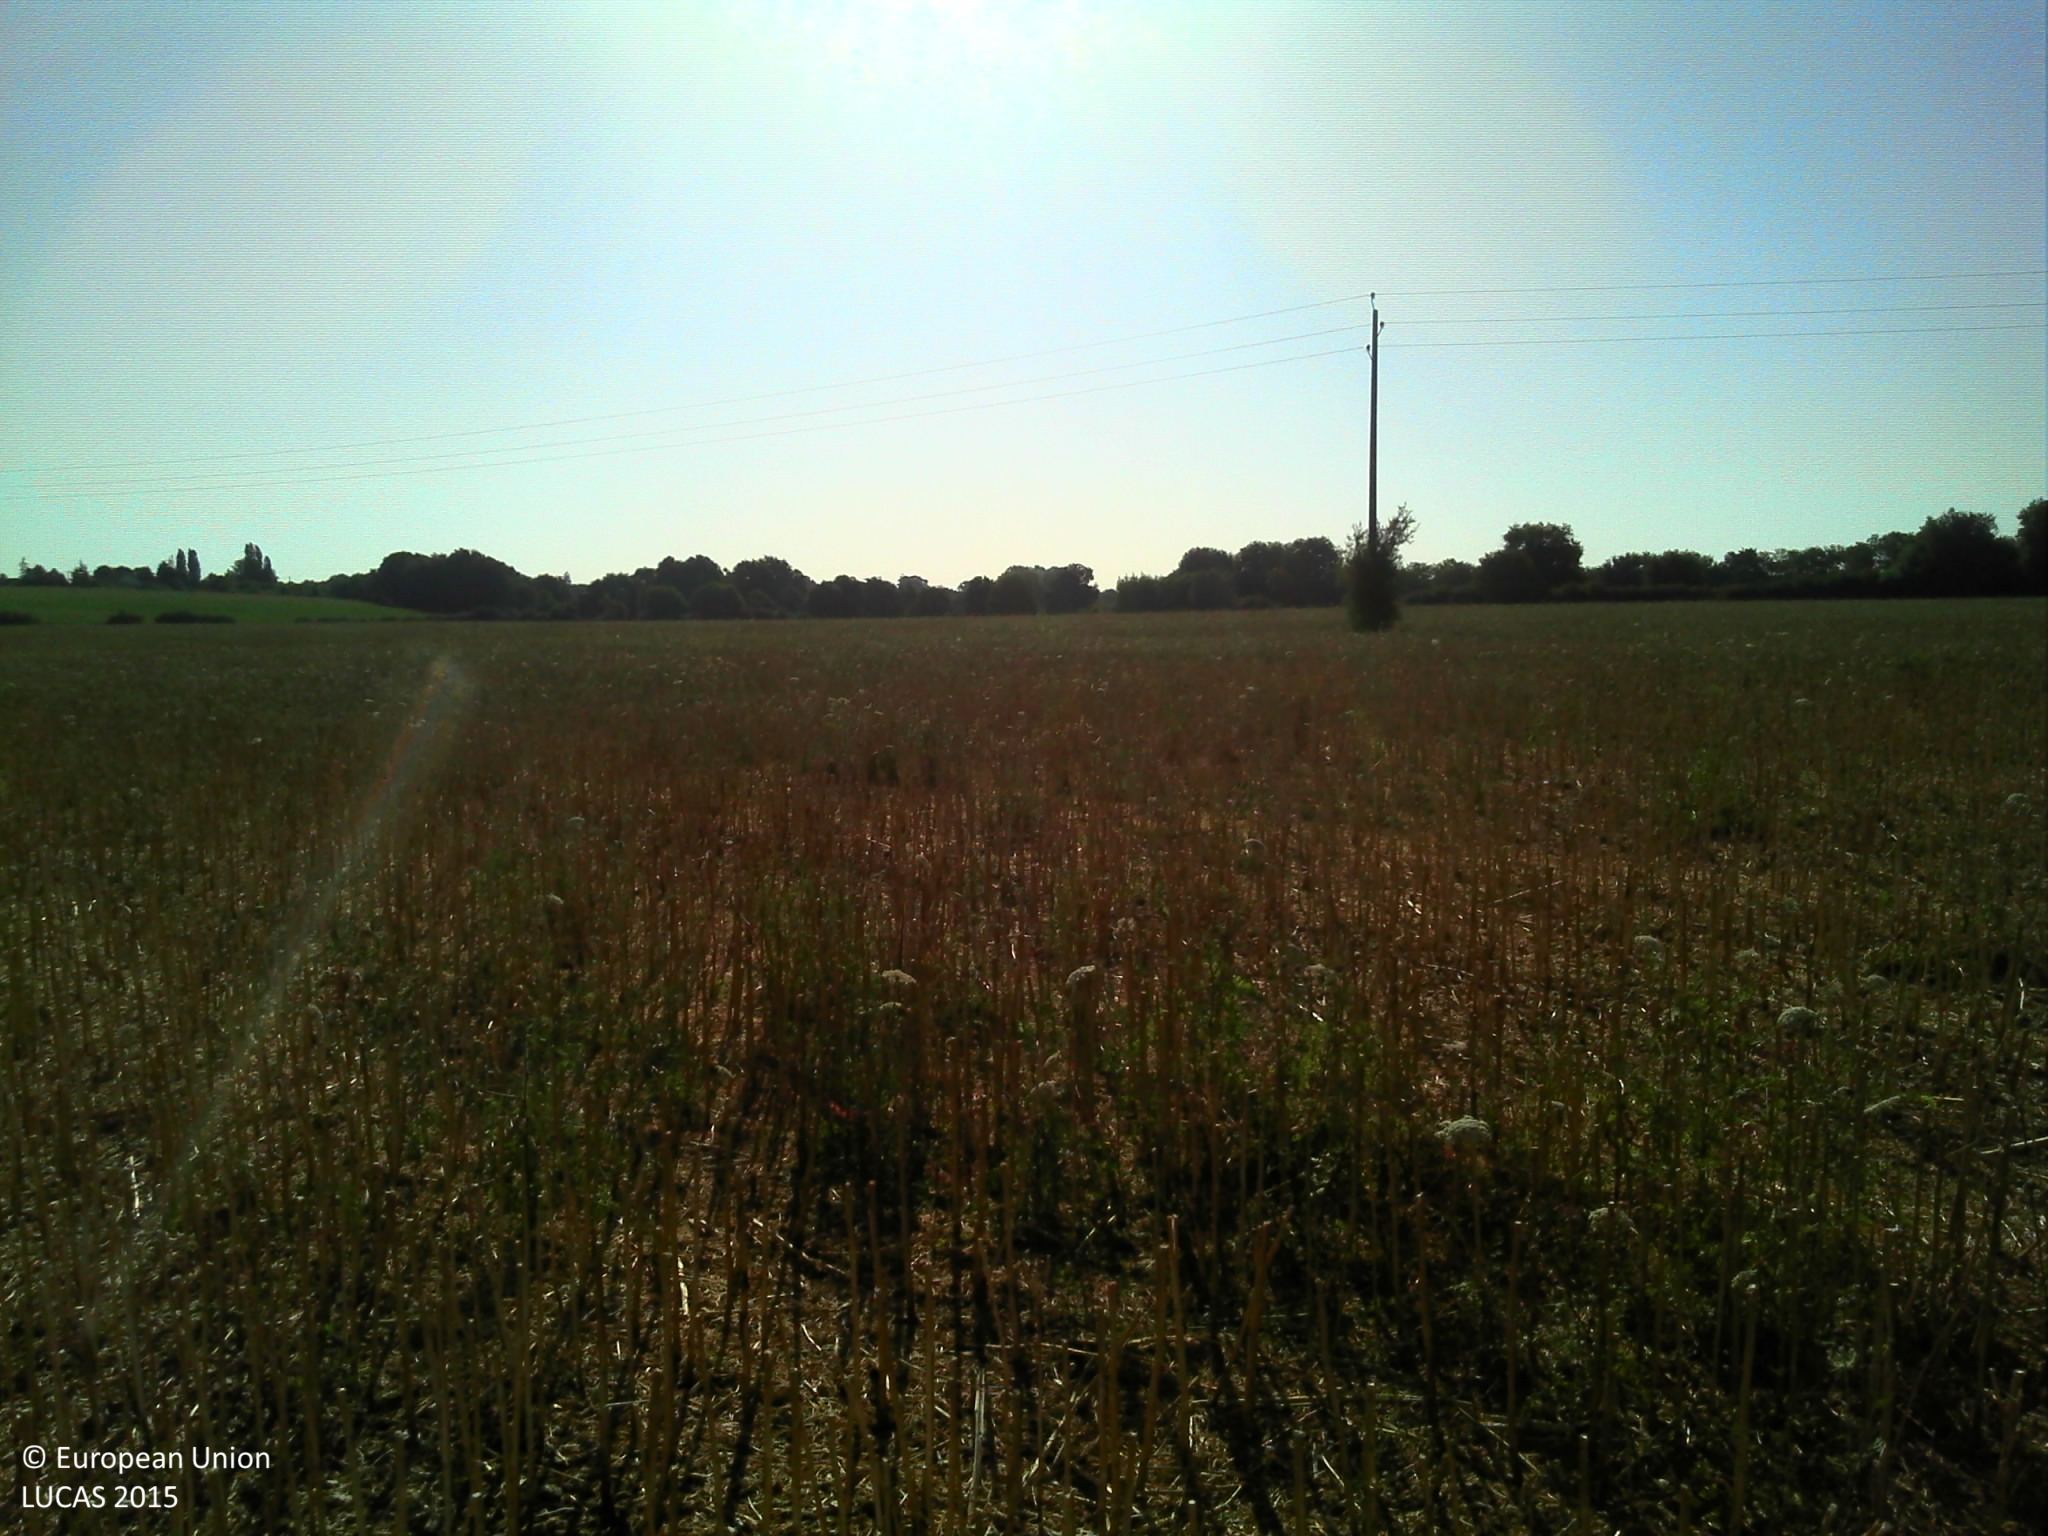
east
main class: Cropland
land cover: Rape and turnip rape
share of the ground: < 10 %
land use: Agriculture (excluding fallow land and kitchen gardens)
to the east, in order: Rape and turnip rape; Electric lines; Rape and turnip rape
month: July
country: FR
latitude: 46.5386
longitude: 0.2397
